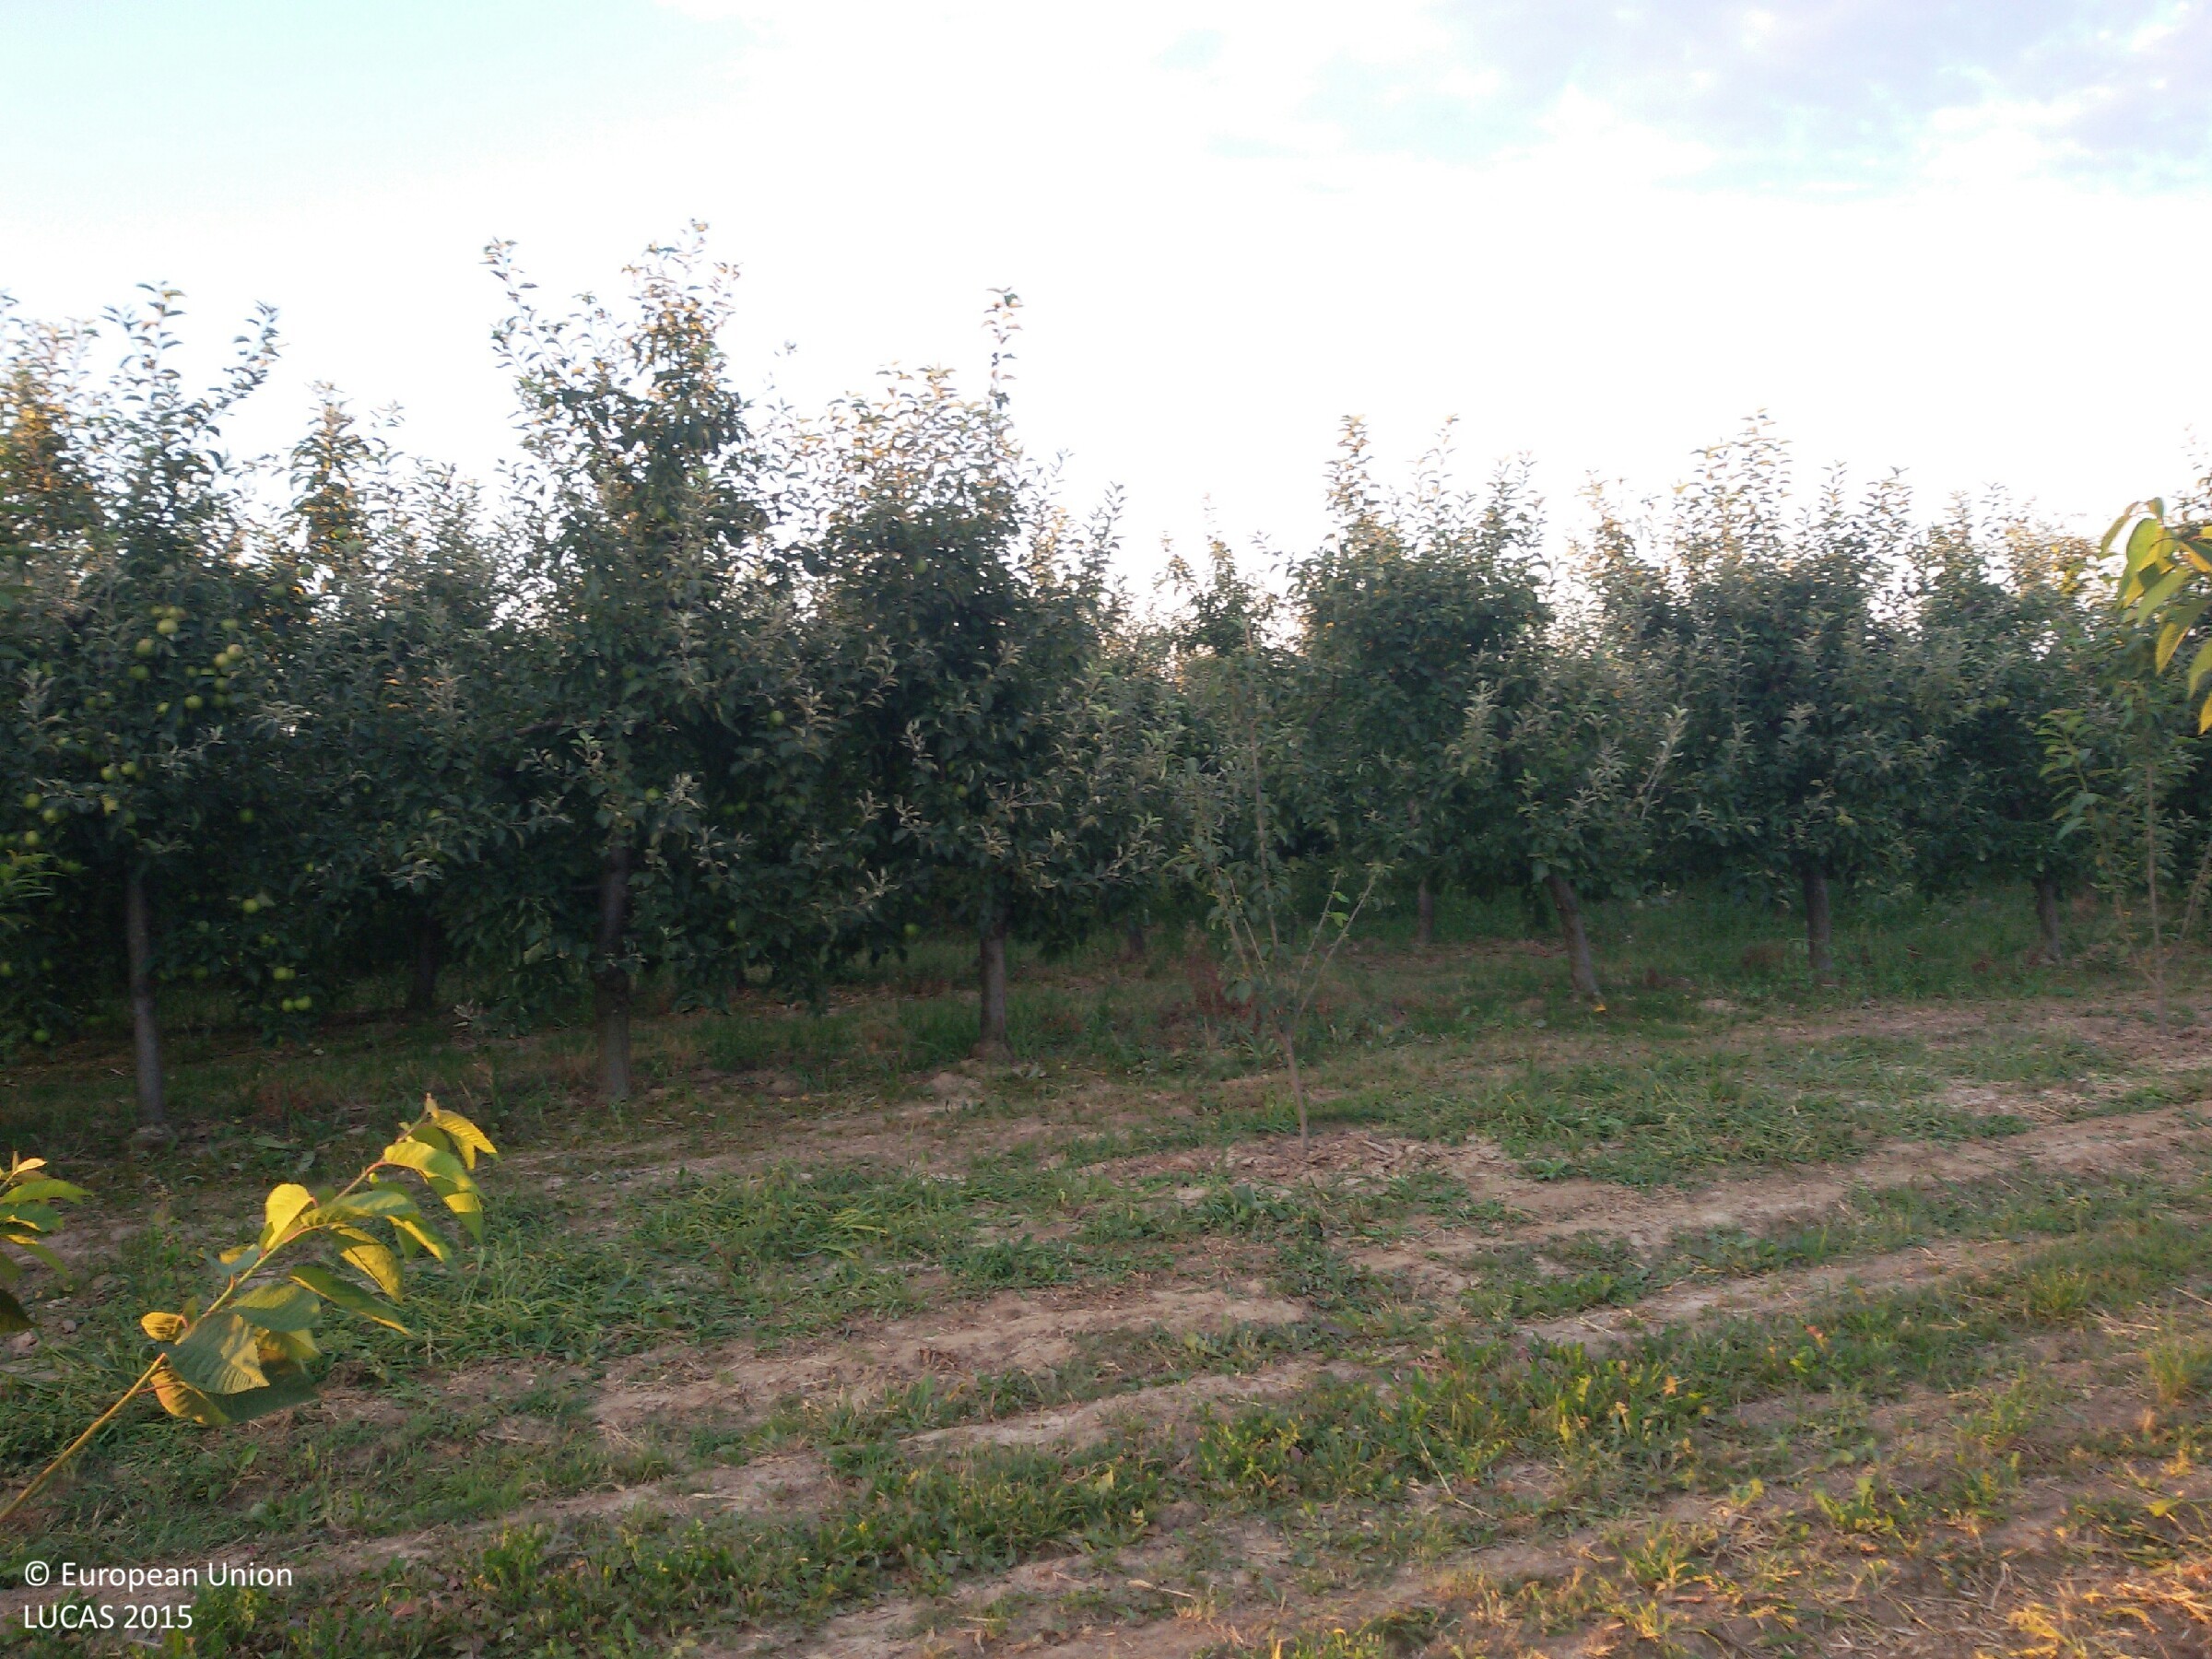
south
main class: Cropland
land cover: Cherry fruit
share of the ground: 50 - 75 %
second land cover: Grassland without tree/shrub cover
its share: > 75 %
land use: Agriculture (excluding fallow land and kitchen gardens)
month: August
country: PL
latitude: 50.7231
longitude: 21.7120
